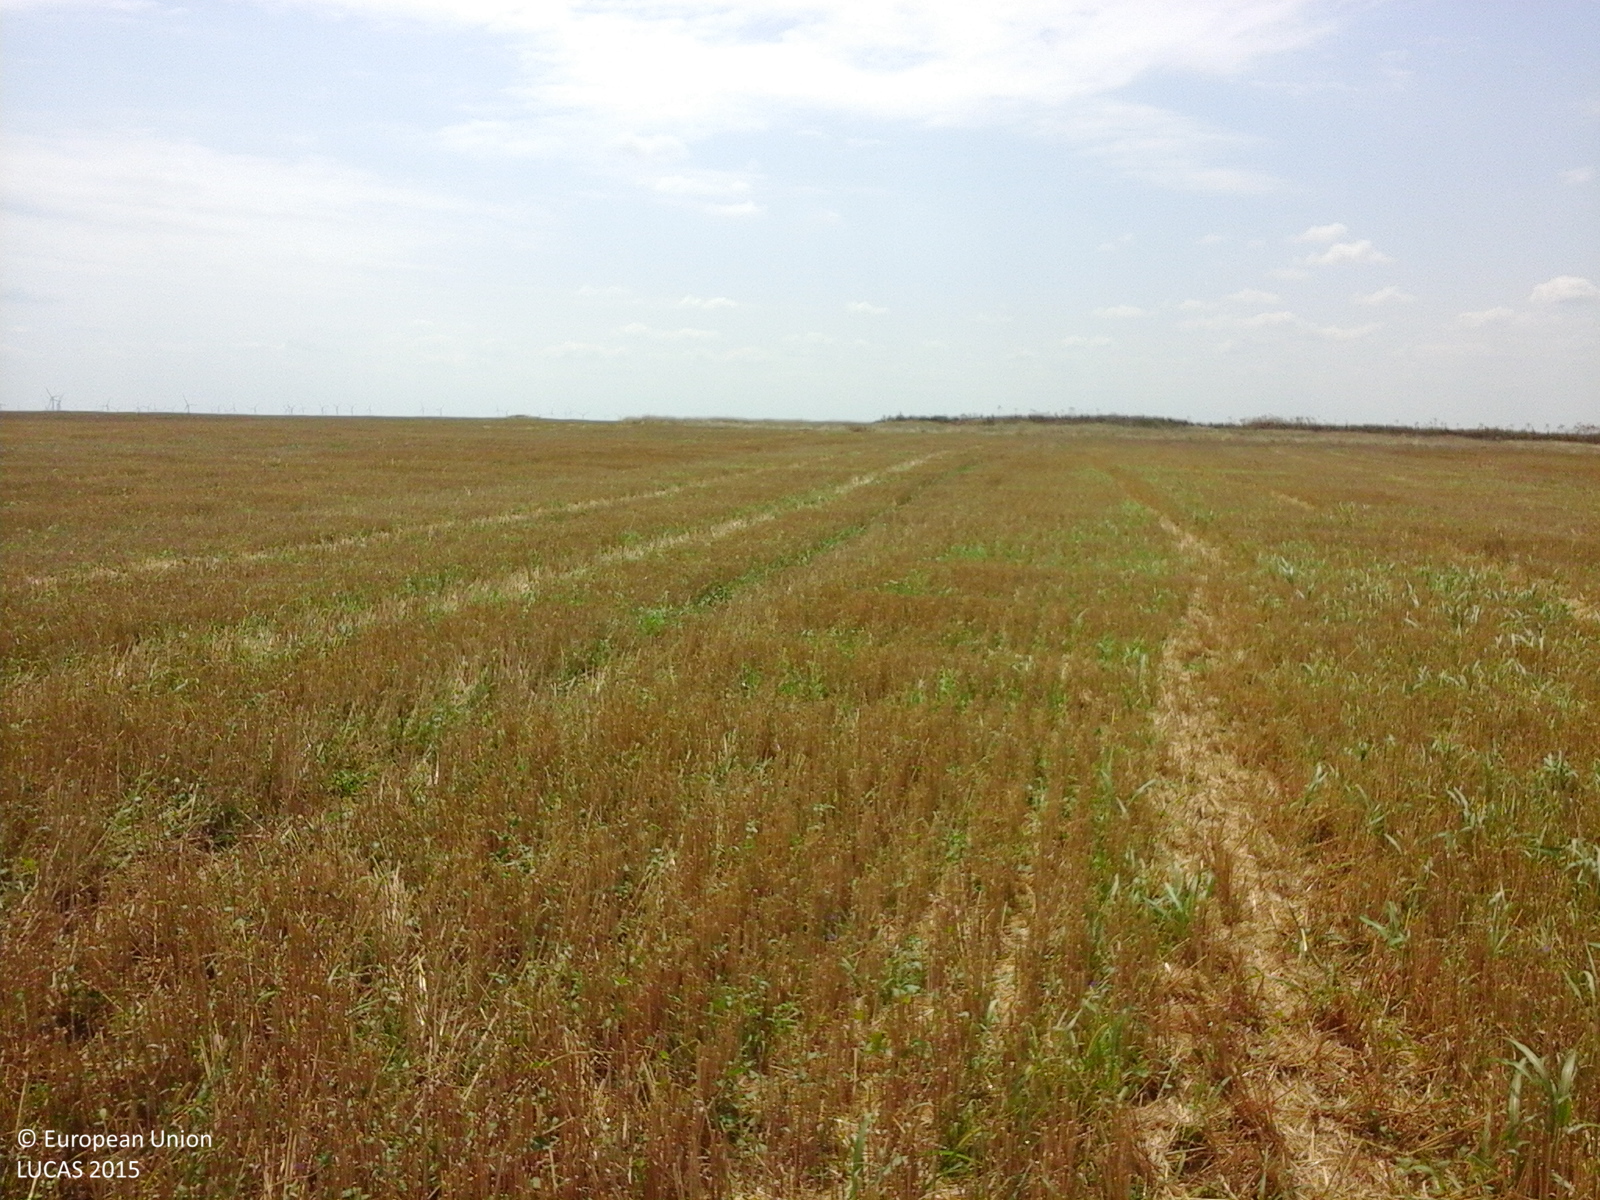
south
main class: Cropland
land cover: Common wheat
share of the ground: > 75 %
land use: Agriculture (excluding fallow land and kitchen gardens)
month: August
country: RO
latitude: 44.6633
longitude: 28.5013
